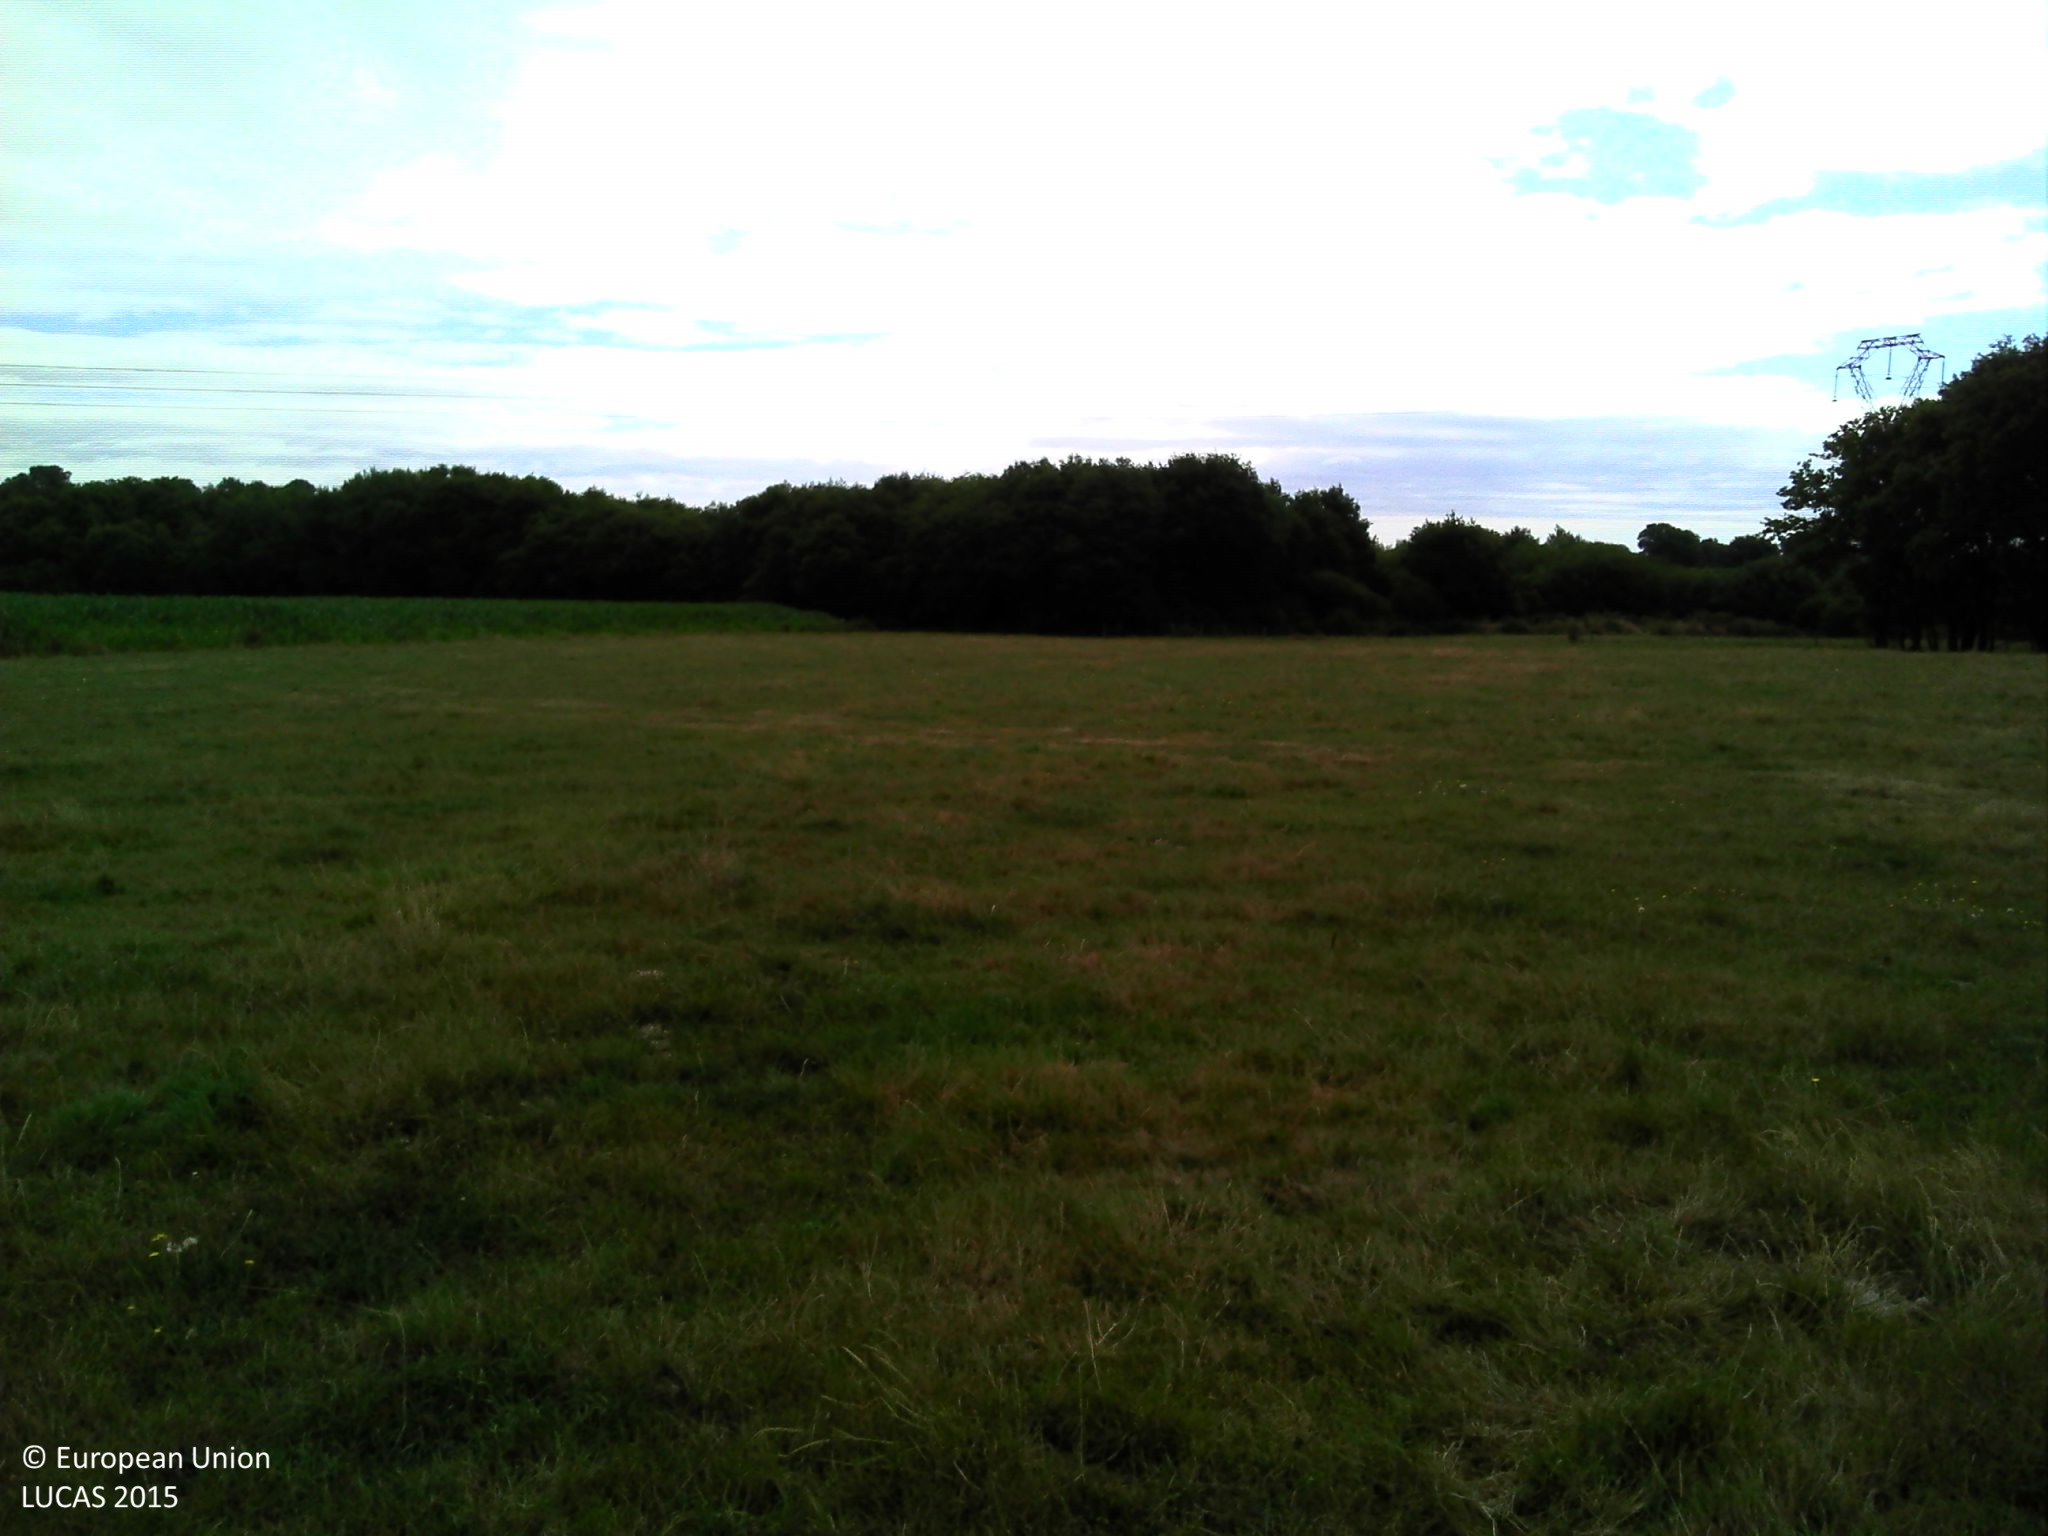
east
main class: Cropland
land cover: Temporary grasslands
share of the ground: > 75 %
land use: Agriculture (excluding fallow land and kitchen gardens)
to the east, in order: Temporary grasslands; Electric lines; Temporary grasslands; Fences; Broadleaved woodland
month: July
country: FR
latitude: 47.4770
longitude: -2.1399
